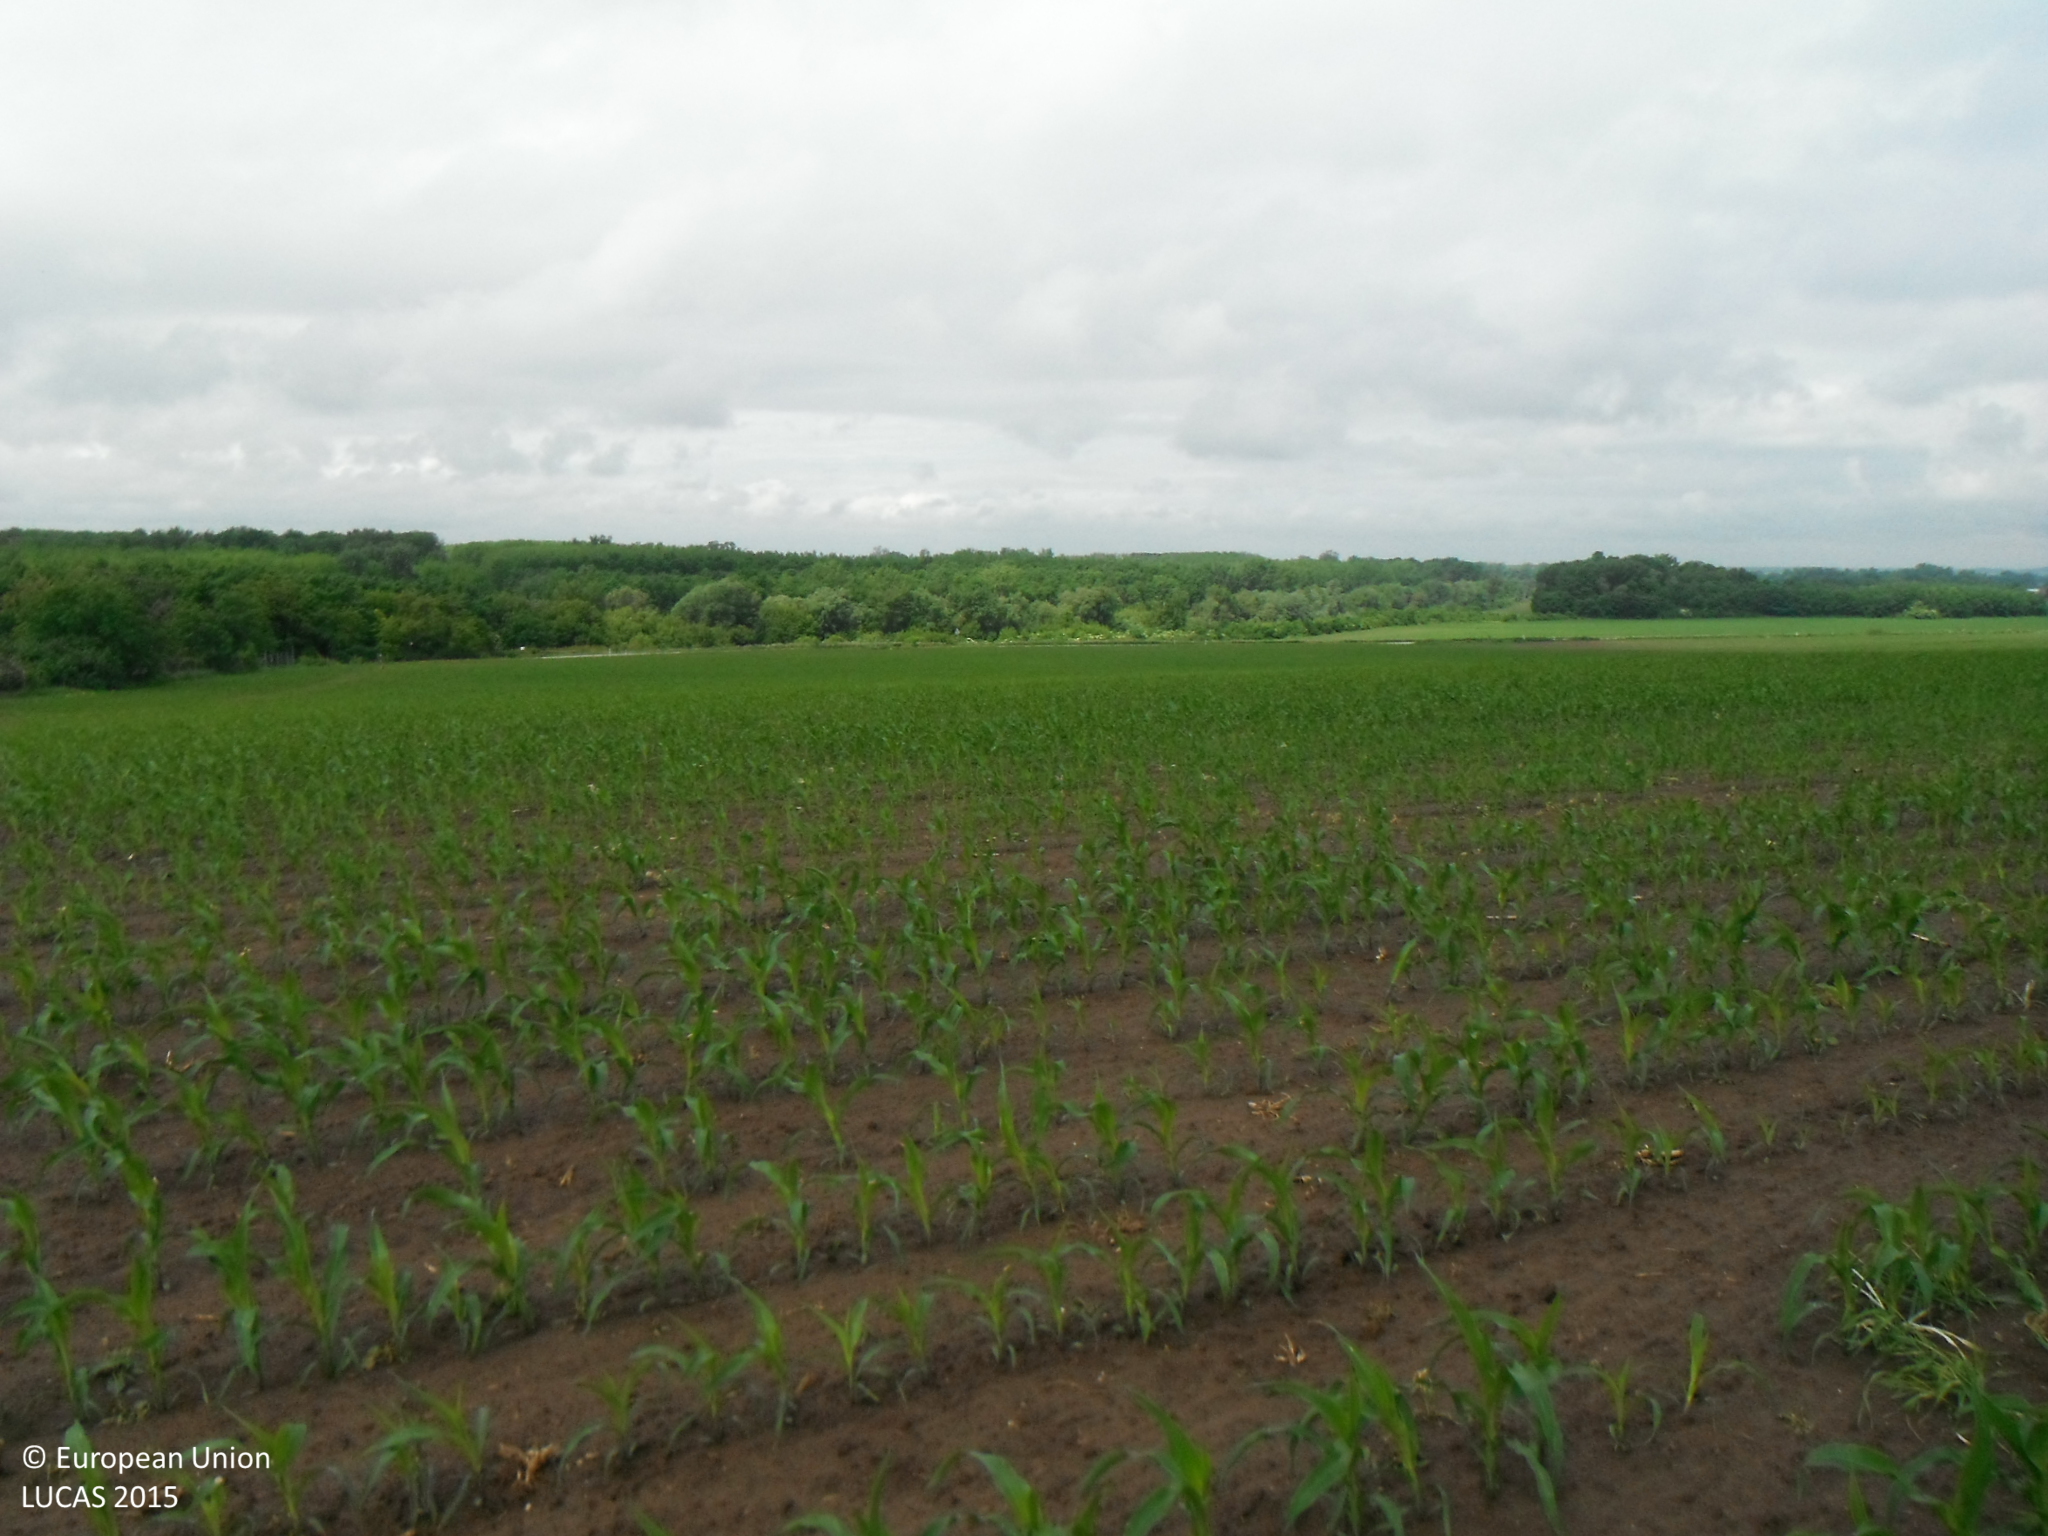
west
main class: Cropland
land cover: Maize
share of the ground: 25 - 50 %
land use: Agriculture (excluding fallow land and kitchen gardens)
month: May
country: SK
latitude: 48.1687
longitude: 18.2299
